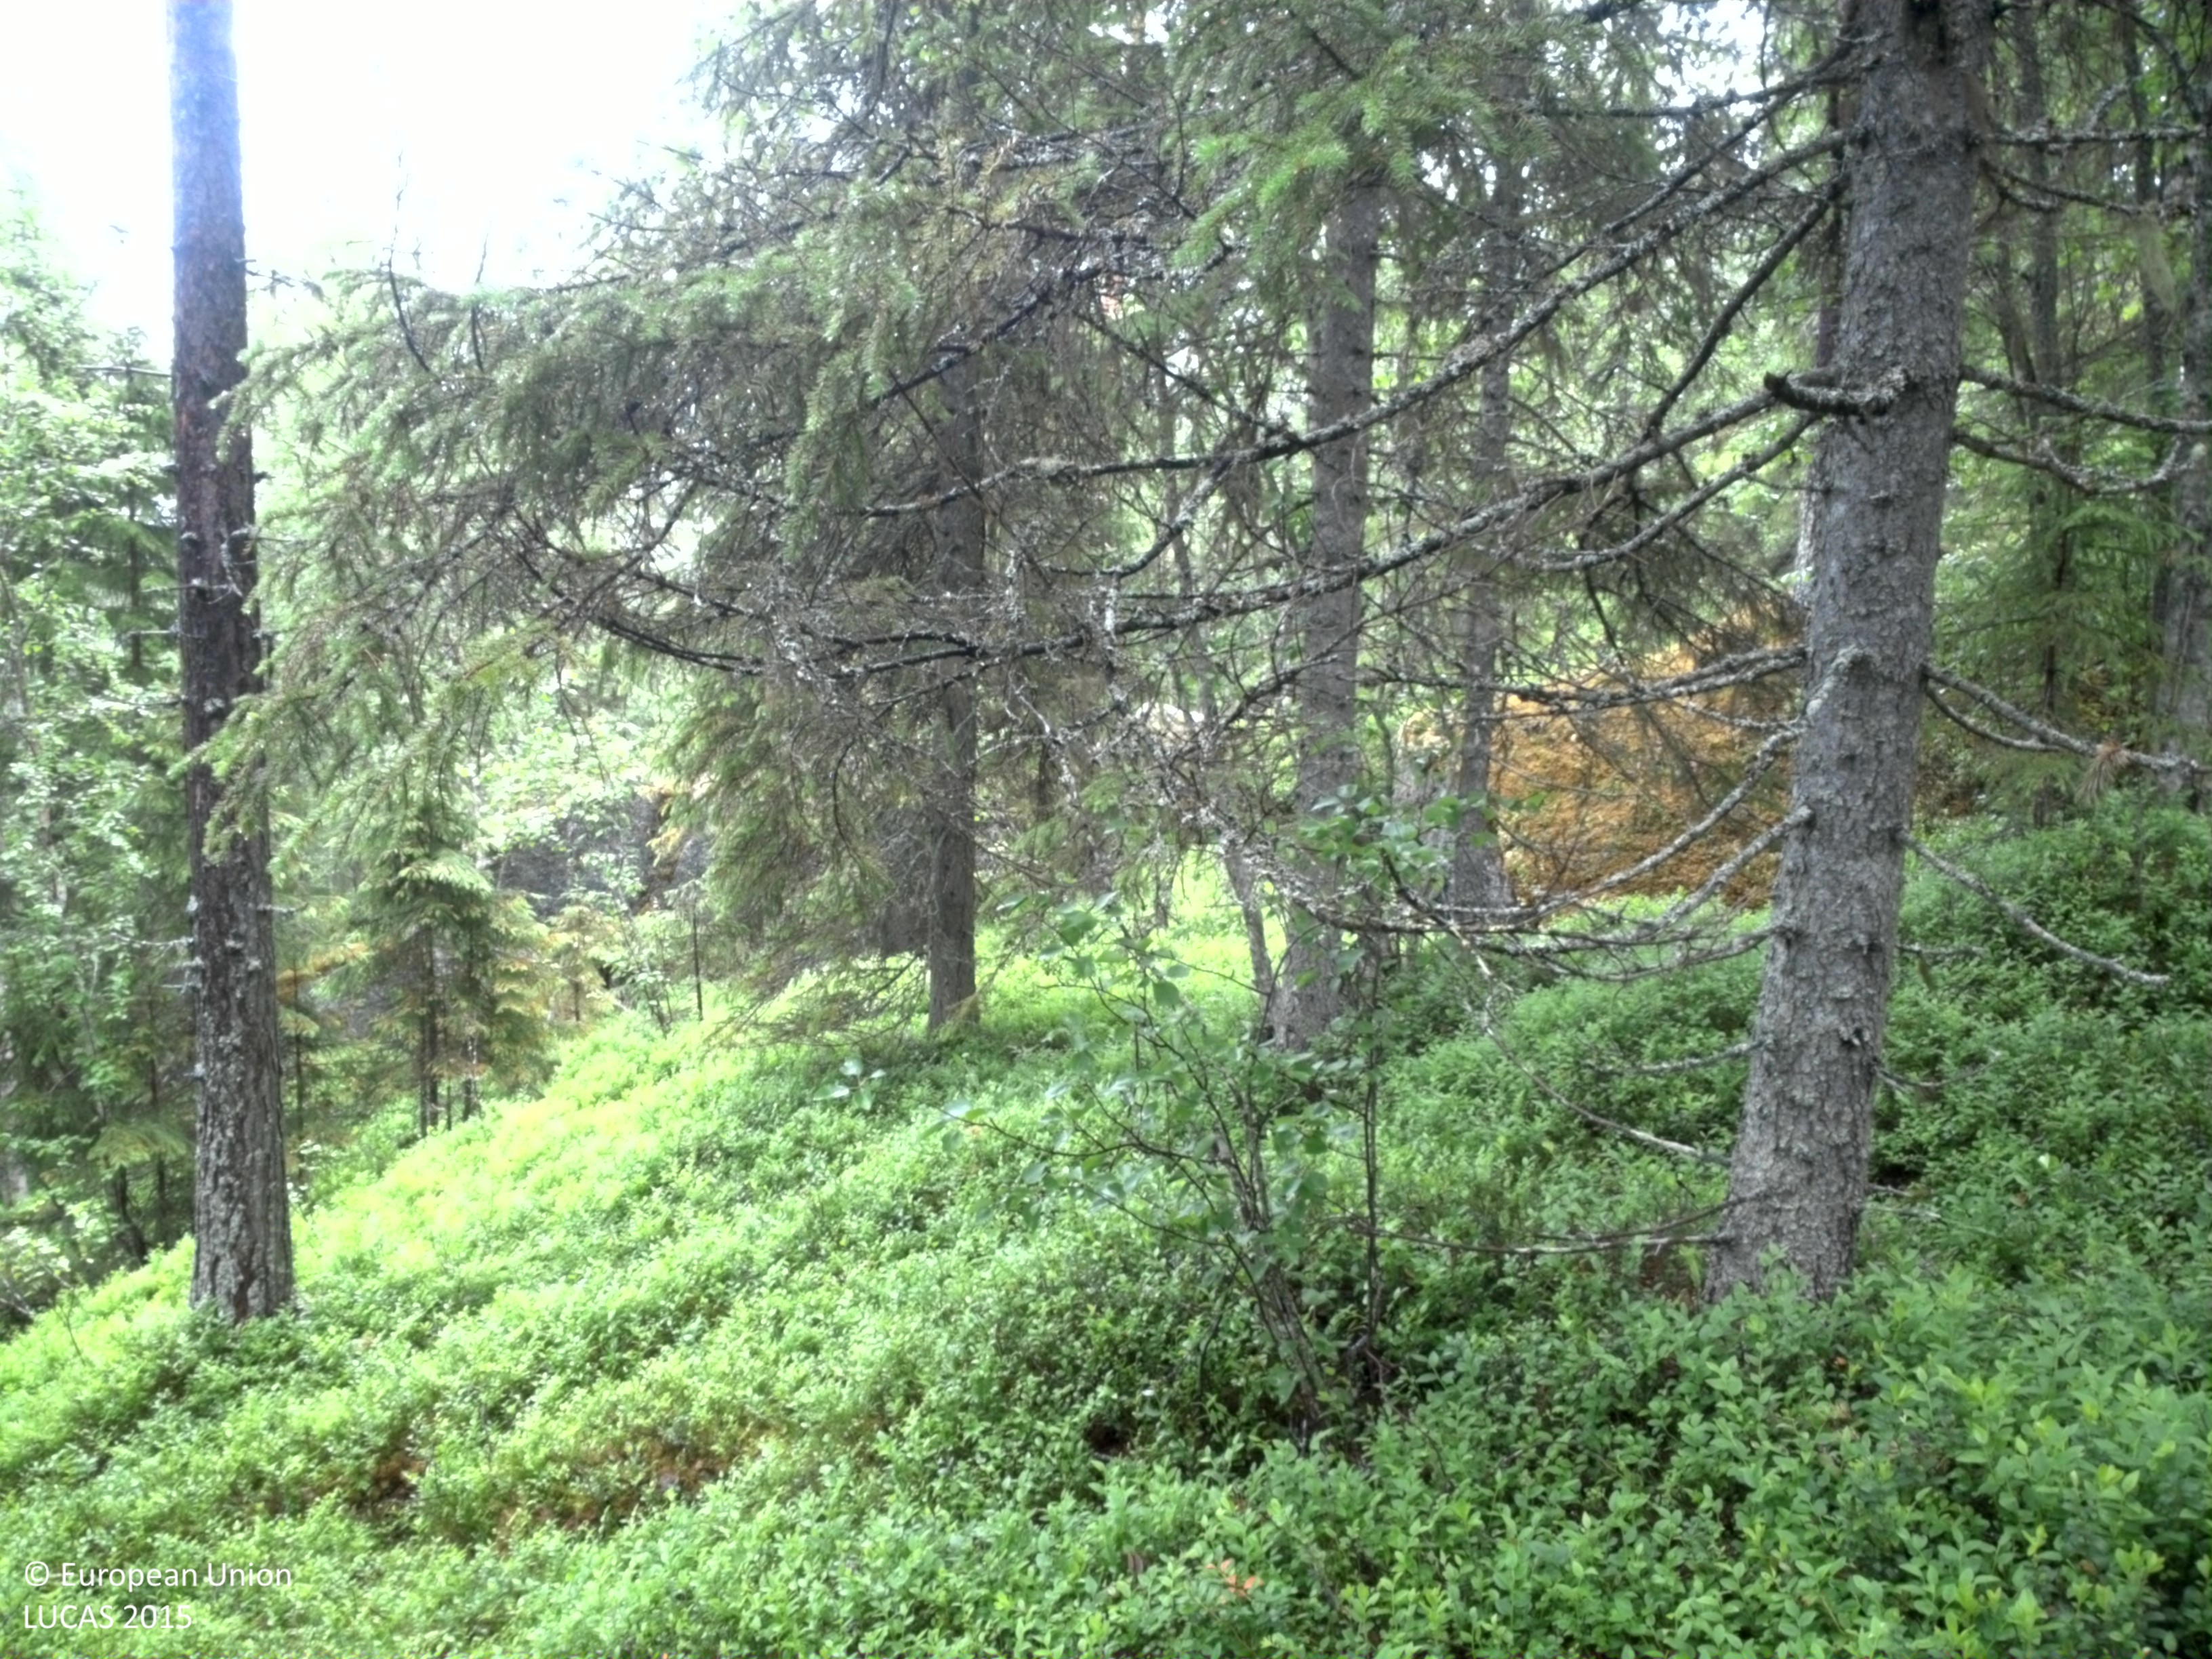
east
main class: Woodland
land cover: Pine dominated coniferous woodland
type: hemiboreal forest and nemoral coniferous forest and mixed broadleaved-coniferous forest
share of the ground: 50 - 75 %
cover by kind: coniferous forest trees 65 %, shrubs 20 %, broadleaved forest trees 10 %, lichens and mosses 5 %
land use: Forestry
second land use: Amenities, museums, leisure
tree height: > 5 m
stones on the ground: 10 - 25 %
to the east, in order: Pine dominated coniferous woodland; Pine dominated mixed woodland; Spruce dominated mixed woodland; Pine dominated mixed woodland; Pine dominated coniferous woodland
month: July
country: SE
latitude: 64.6207
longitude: 18.2267
